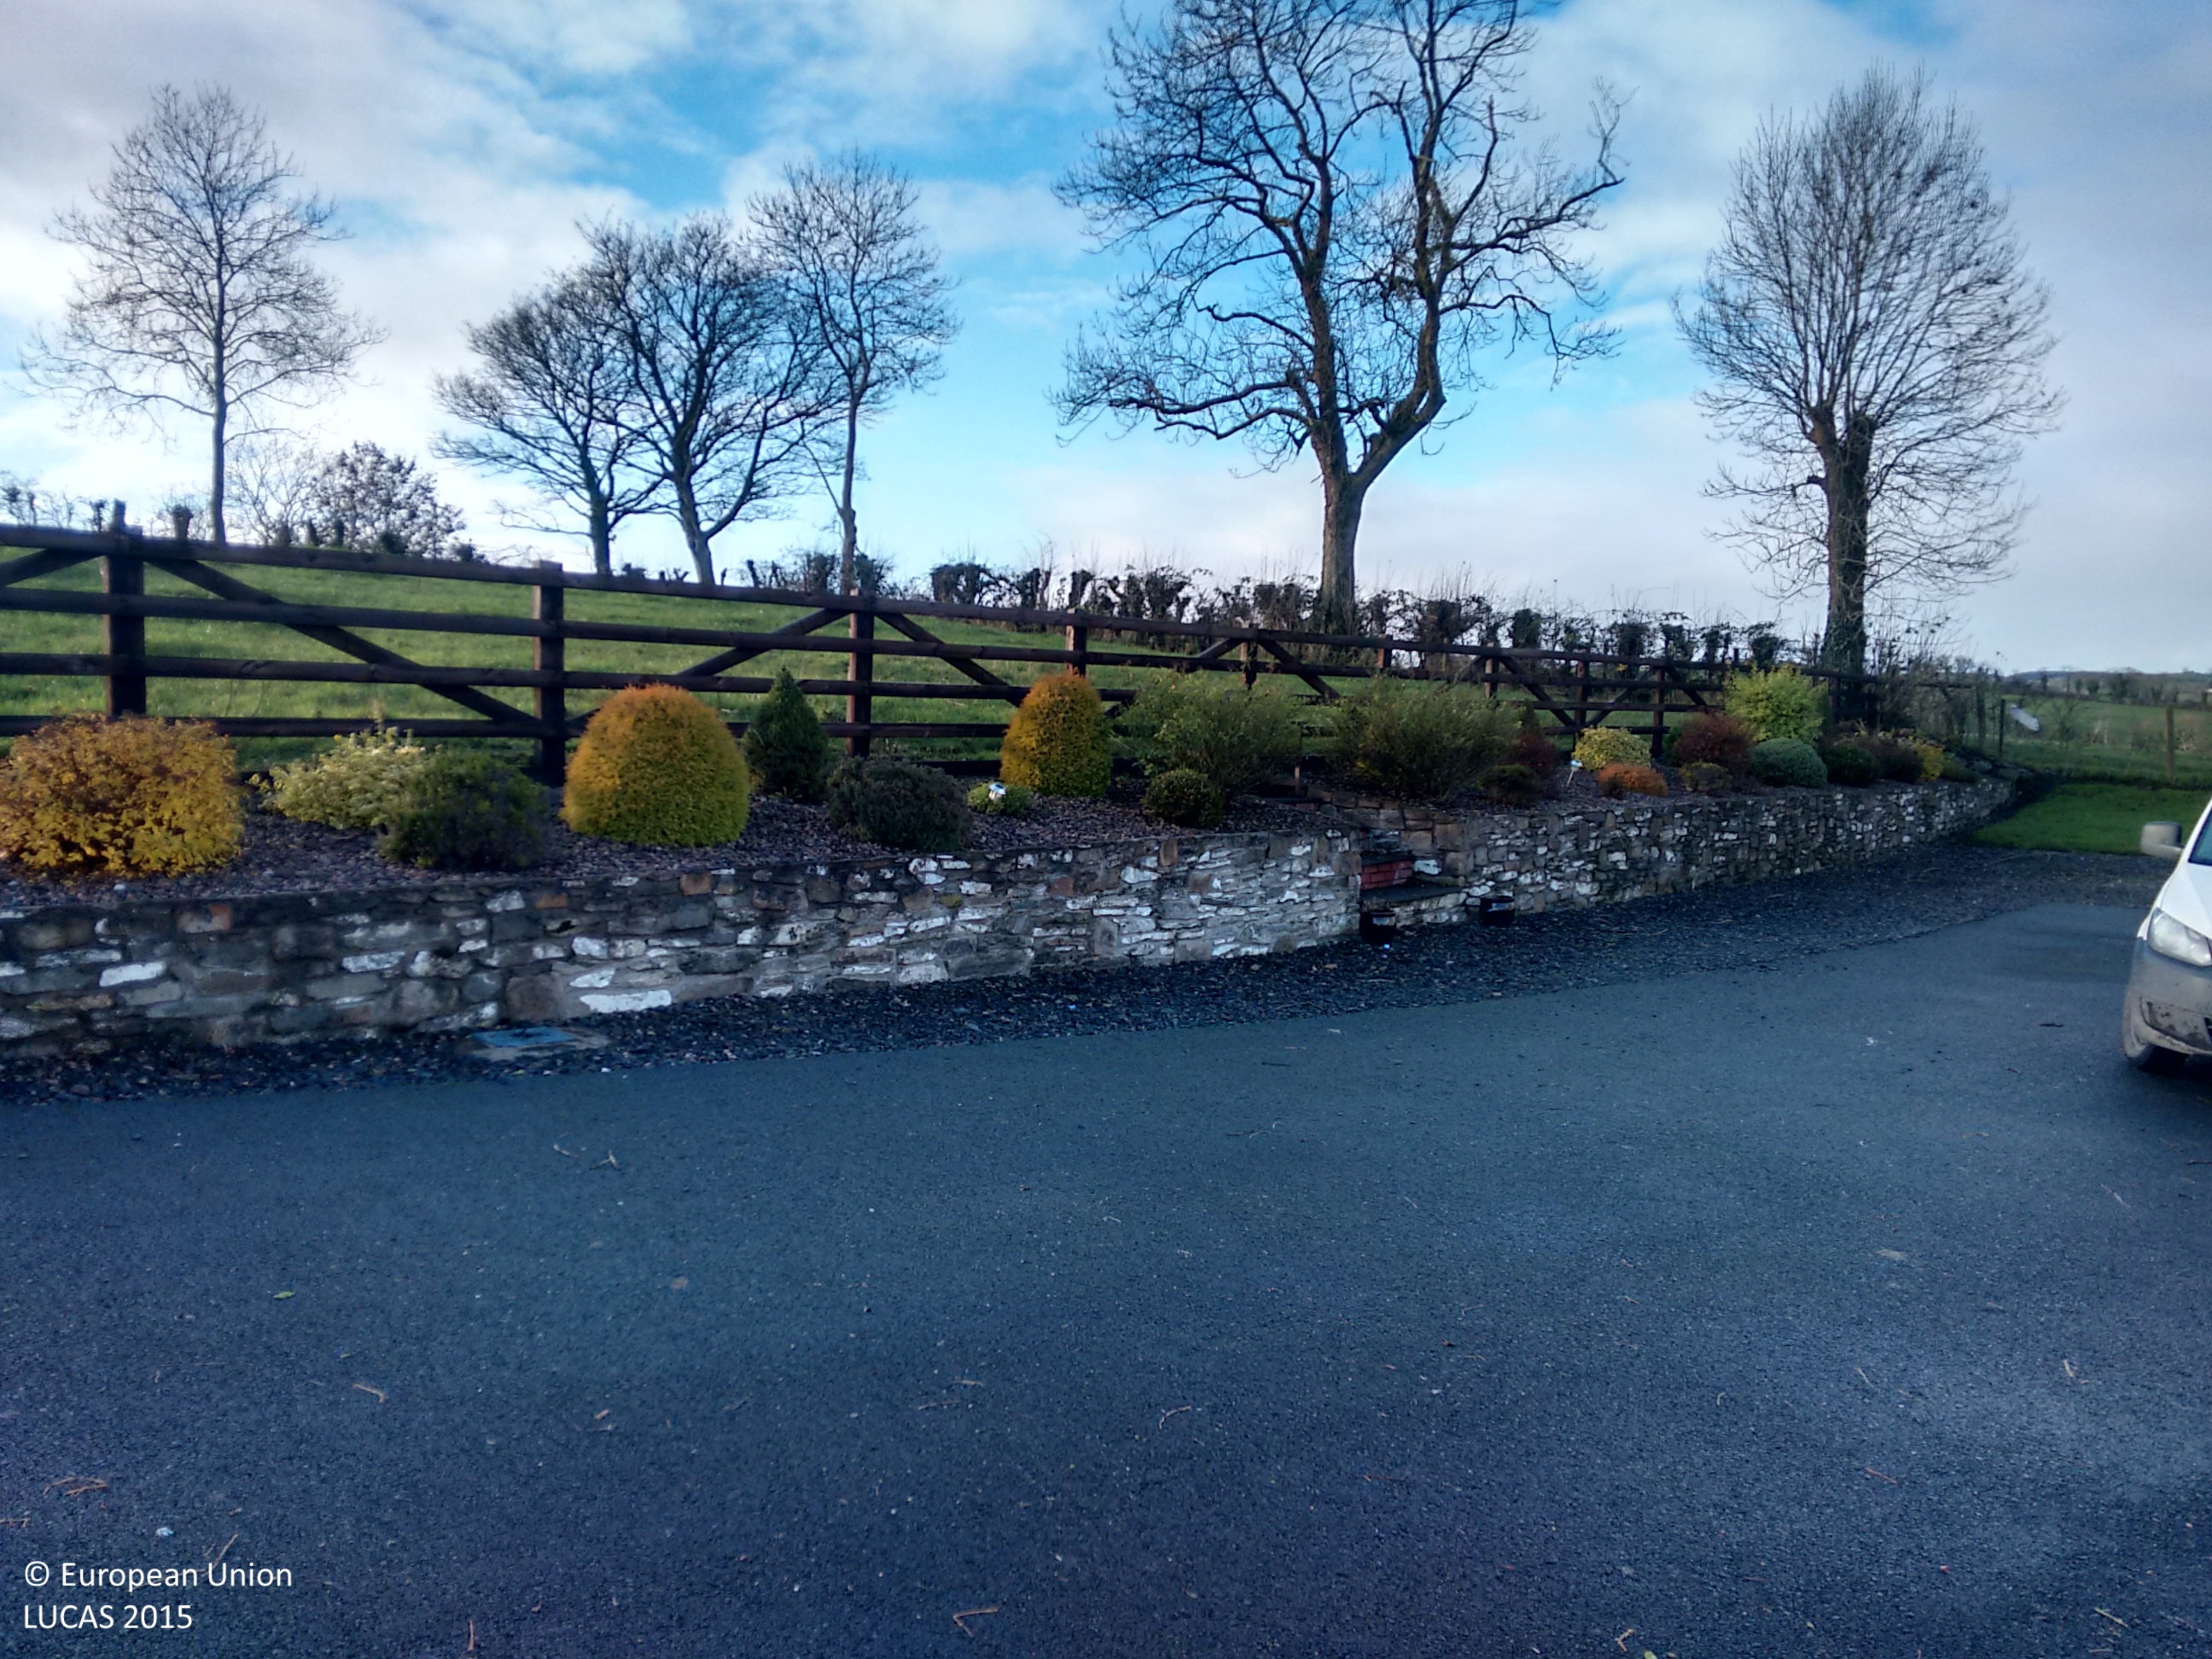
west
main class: Grassland
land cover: Grassland without tree/shrub cover
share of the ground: > 75 %
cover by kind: herbaceous plants 100 %
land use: Agriculture (excluding fallow land and kitchen gardens)
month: December
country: IE
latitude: 53.9425
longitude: -6.8173
